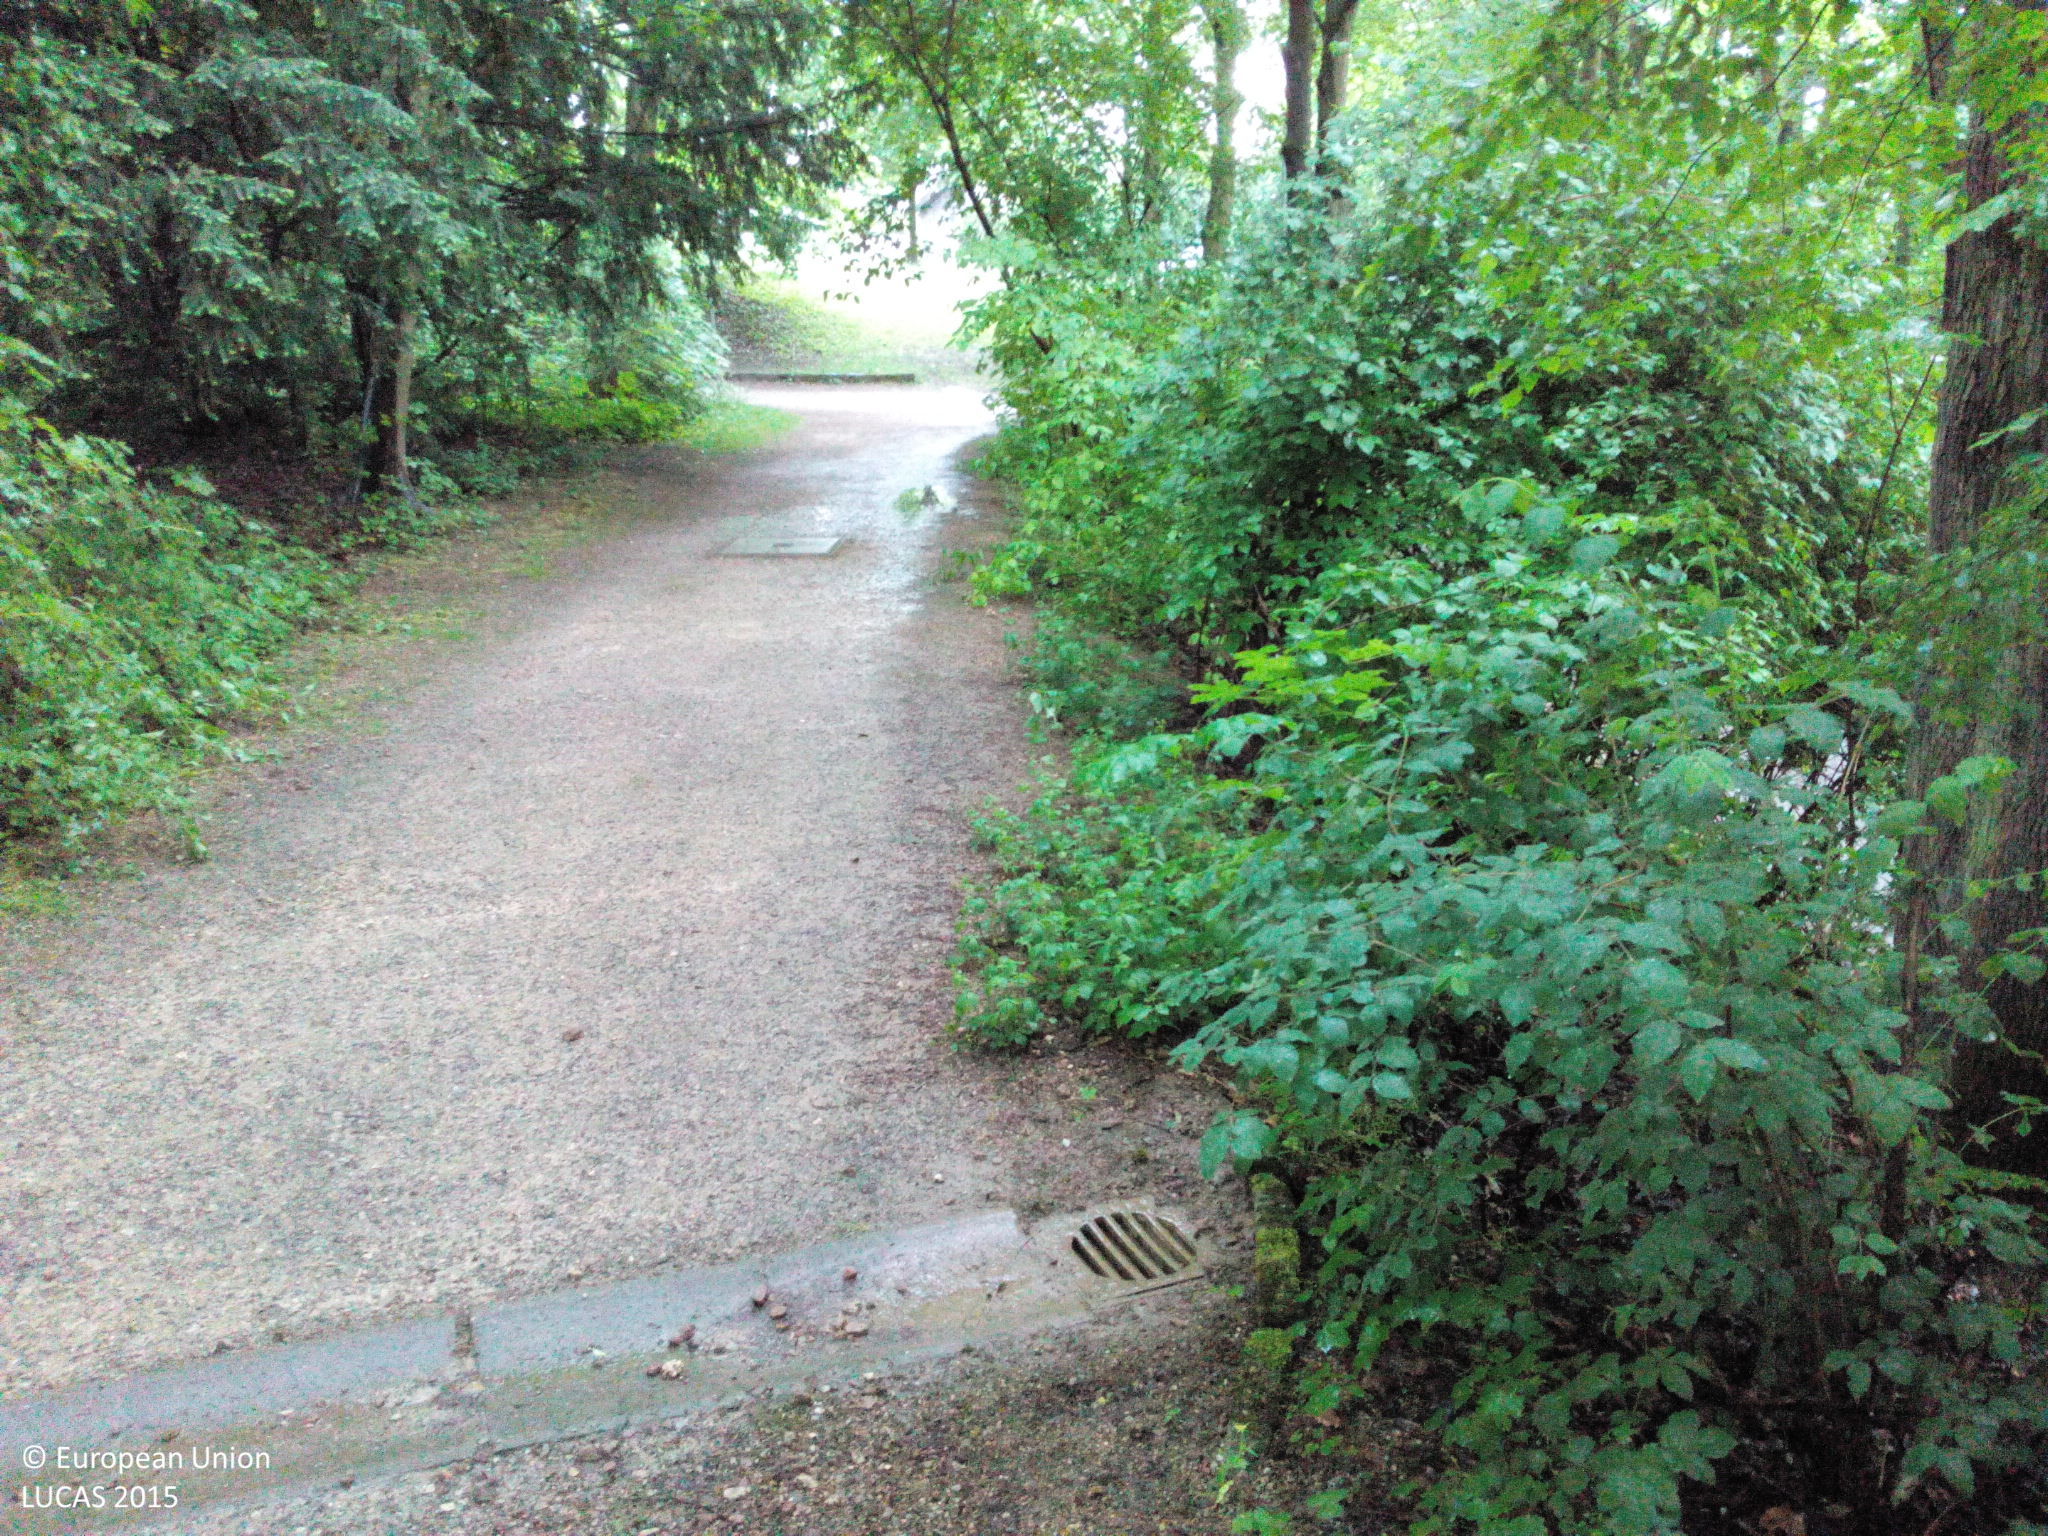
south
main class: Woodland
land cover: Broadleaved woodland
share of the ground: > 75 %
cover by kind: broadleaved forest trees 70 %, shrubs 15 %, unconsolidated bare surface 10 %, coniferous forest trees 5 %
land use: Road transport
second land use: Amenities, museums, leisure
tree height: > 5 m
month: May
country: DE
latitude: 49.0316
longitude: 12.0920
